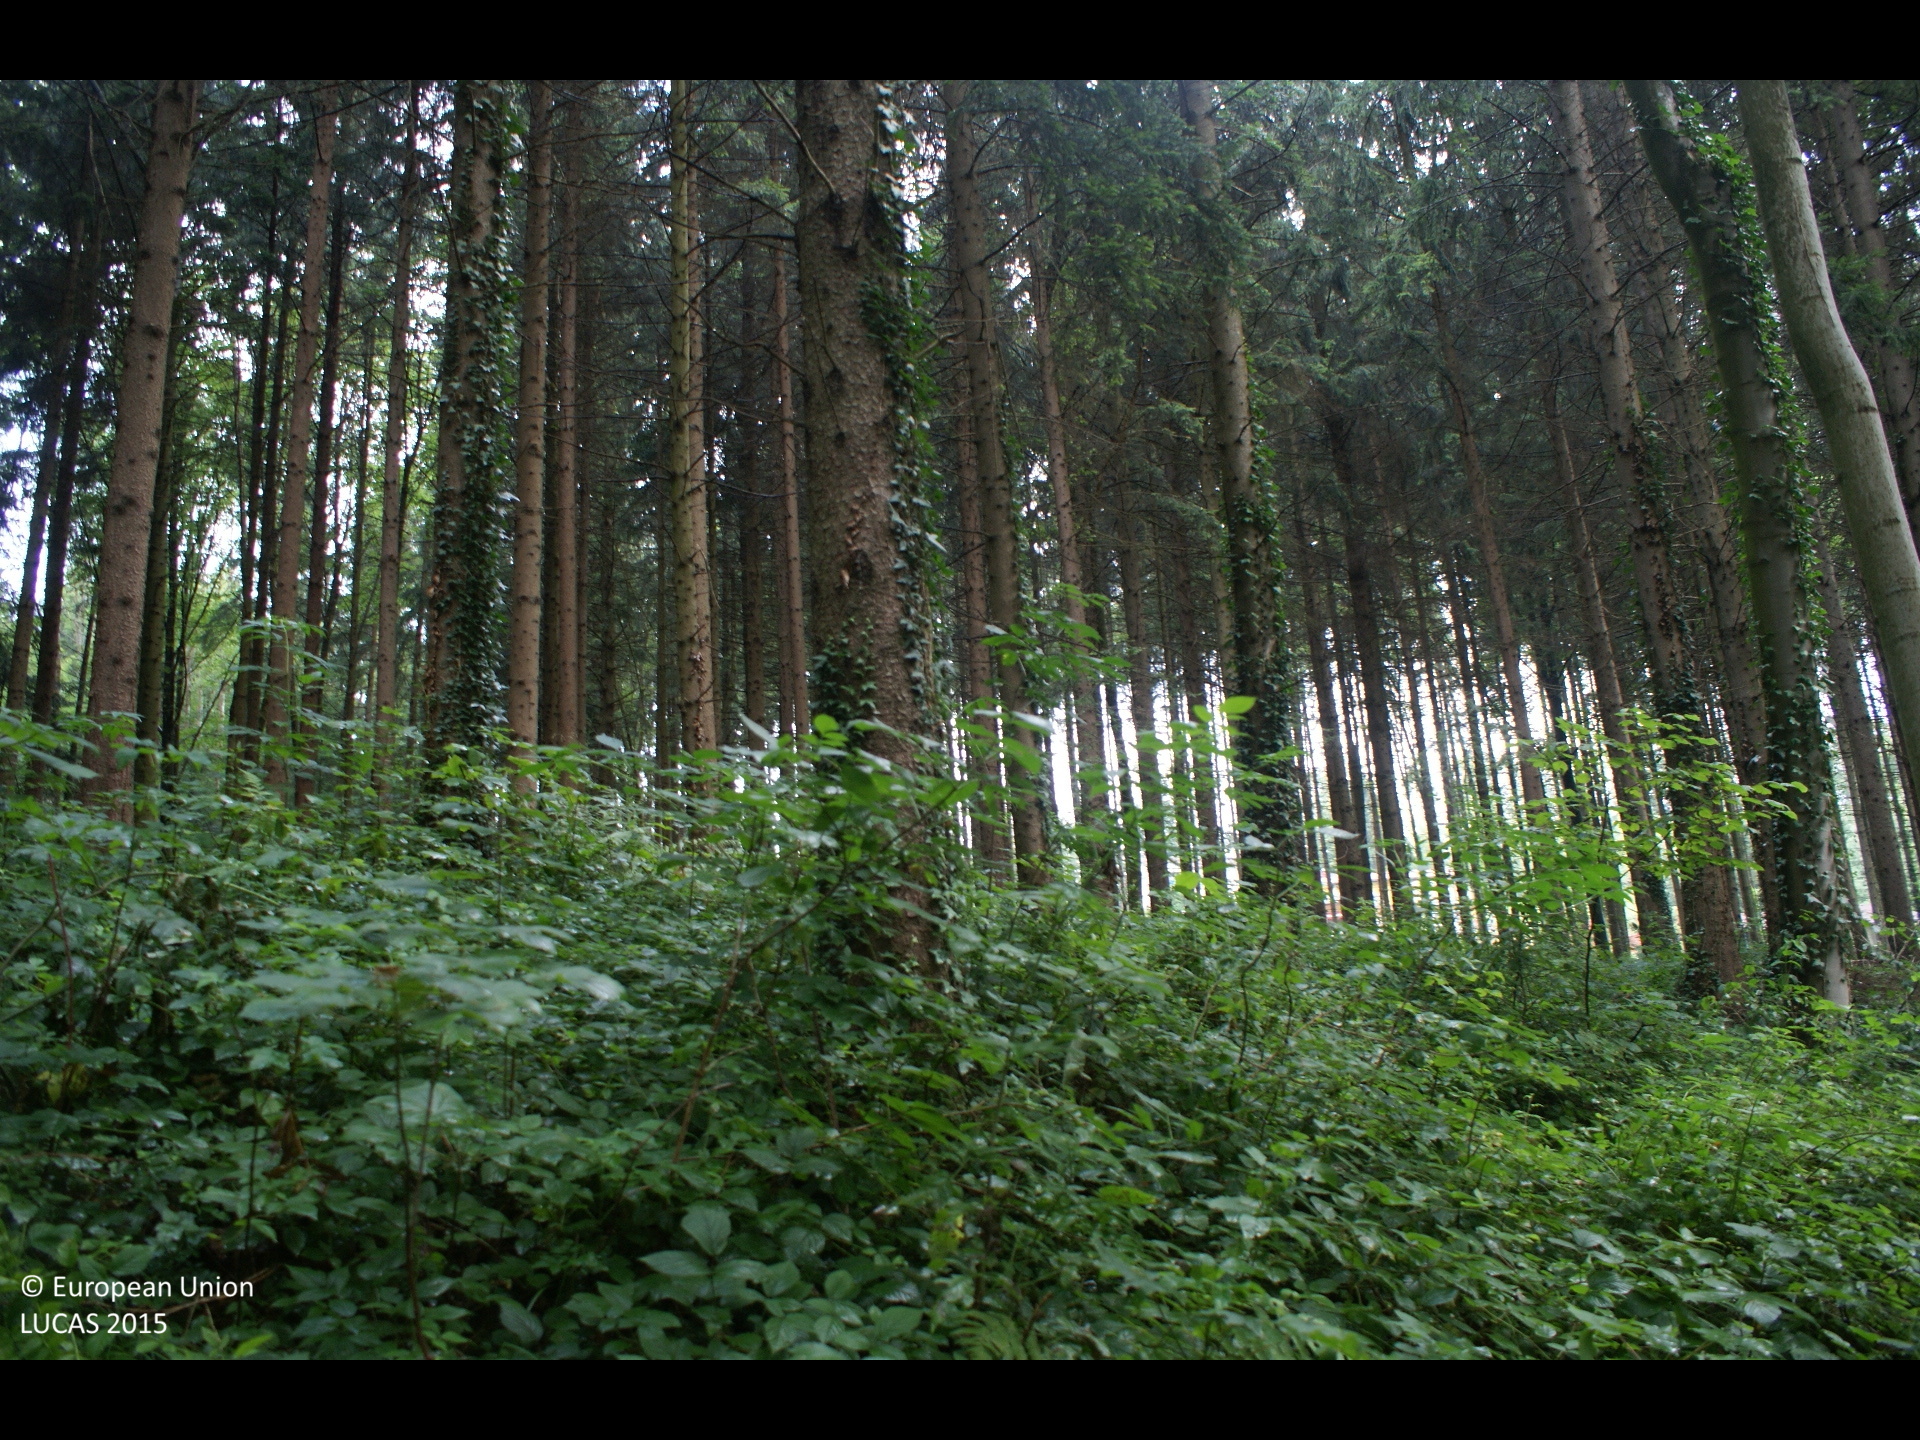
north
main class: Woodland
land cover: Spruce dominated mixed woodland
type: alpine coniferous forest
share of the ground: > 75 %
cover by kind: coniferous forest trees 60 %, broadleaved forest trees 25 %, herbaceous plants 10 %, shrubs 5 %
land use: Forestry
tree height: > 5 m
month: July
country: AT
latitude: 47.9495
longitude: 13.5740
